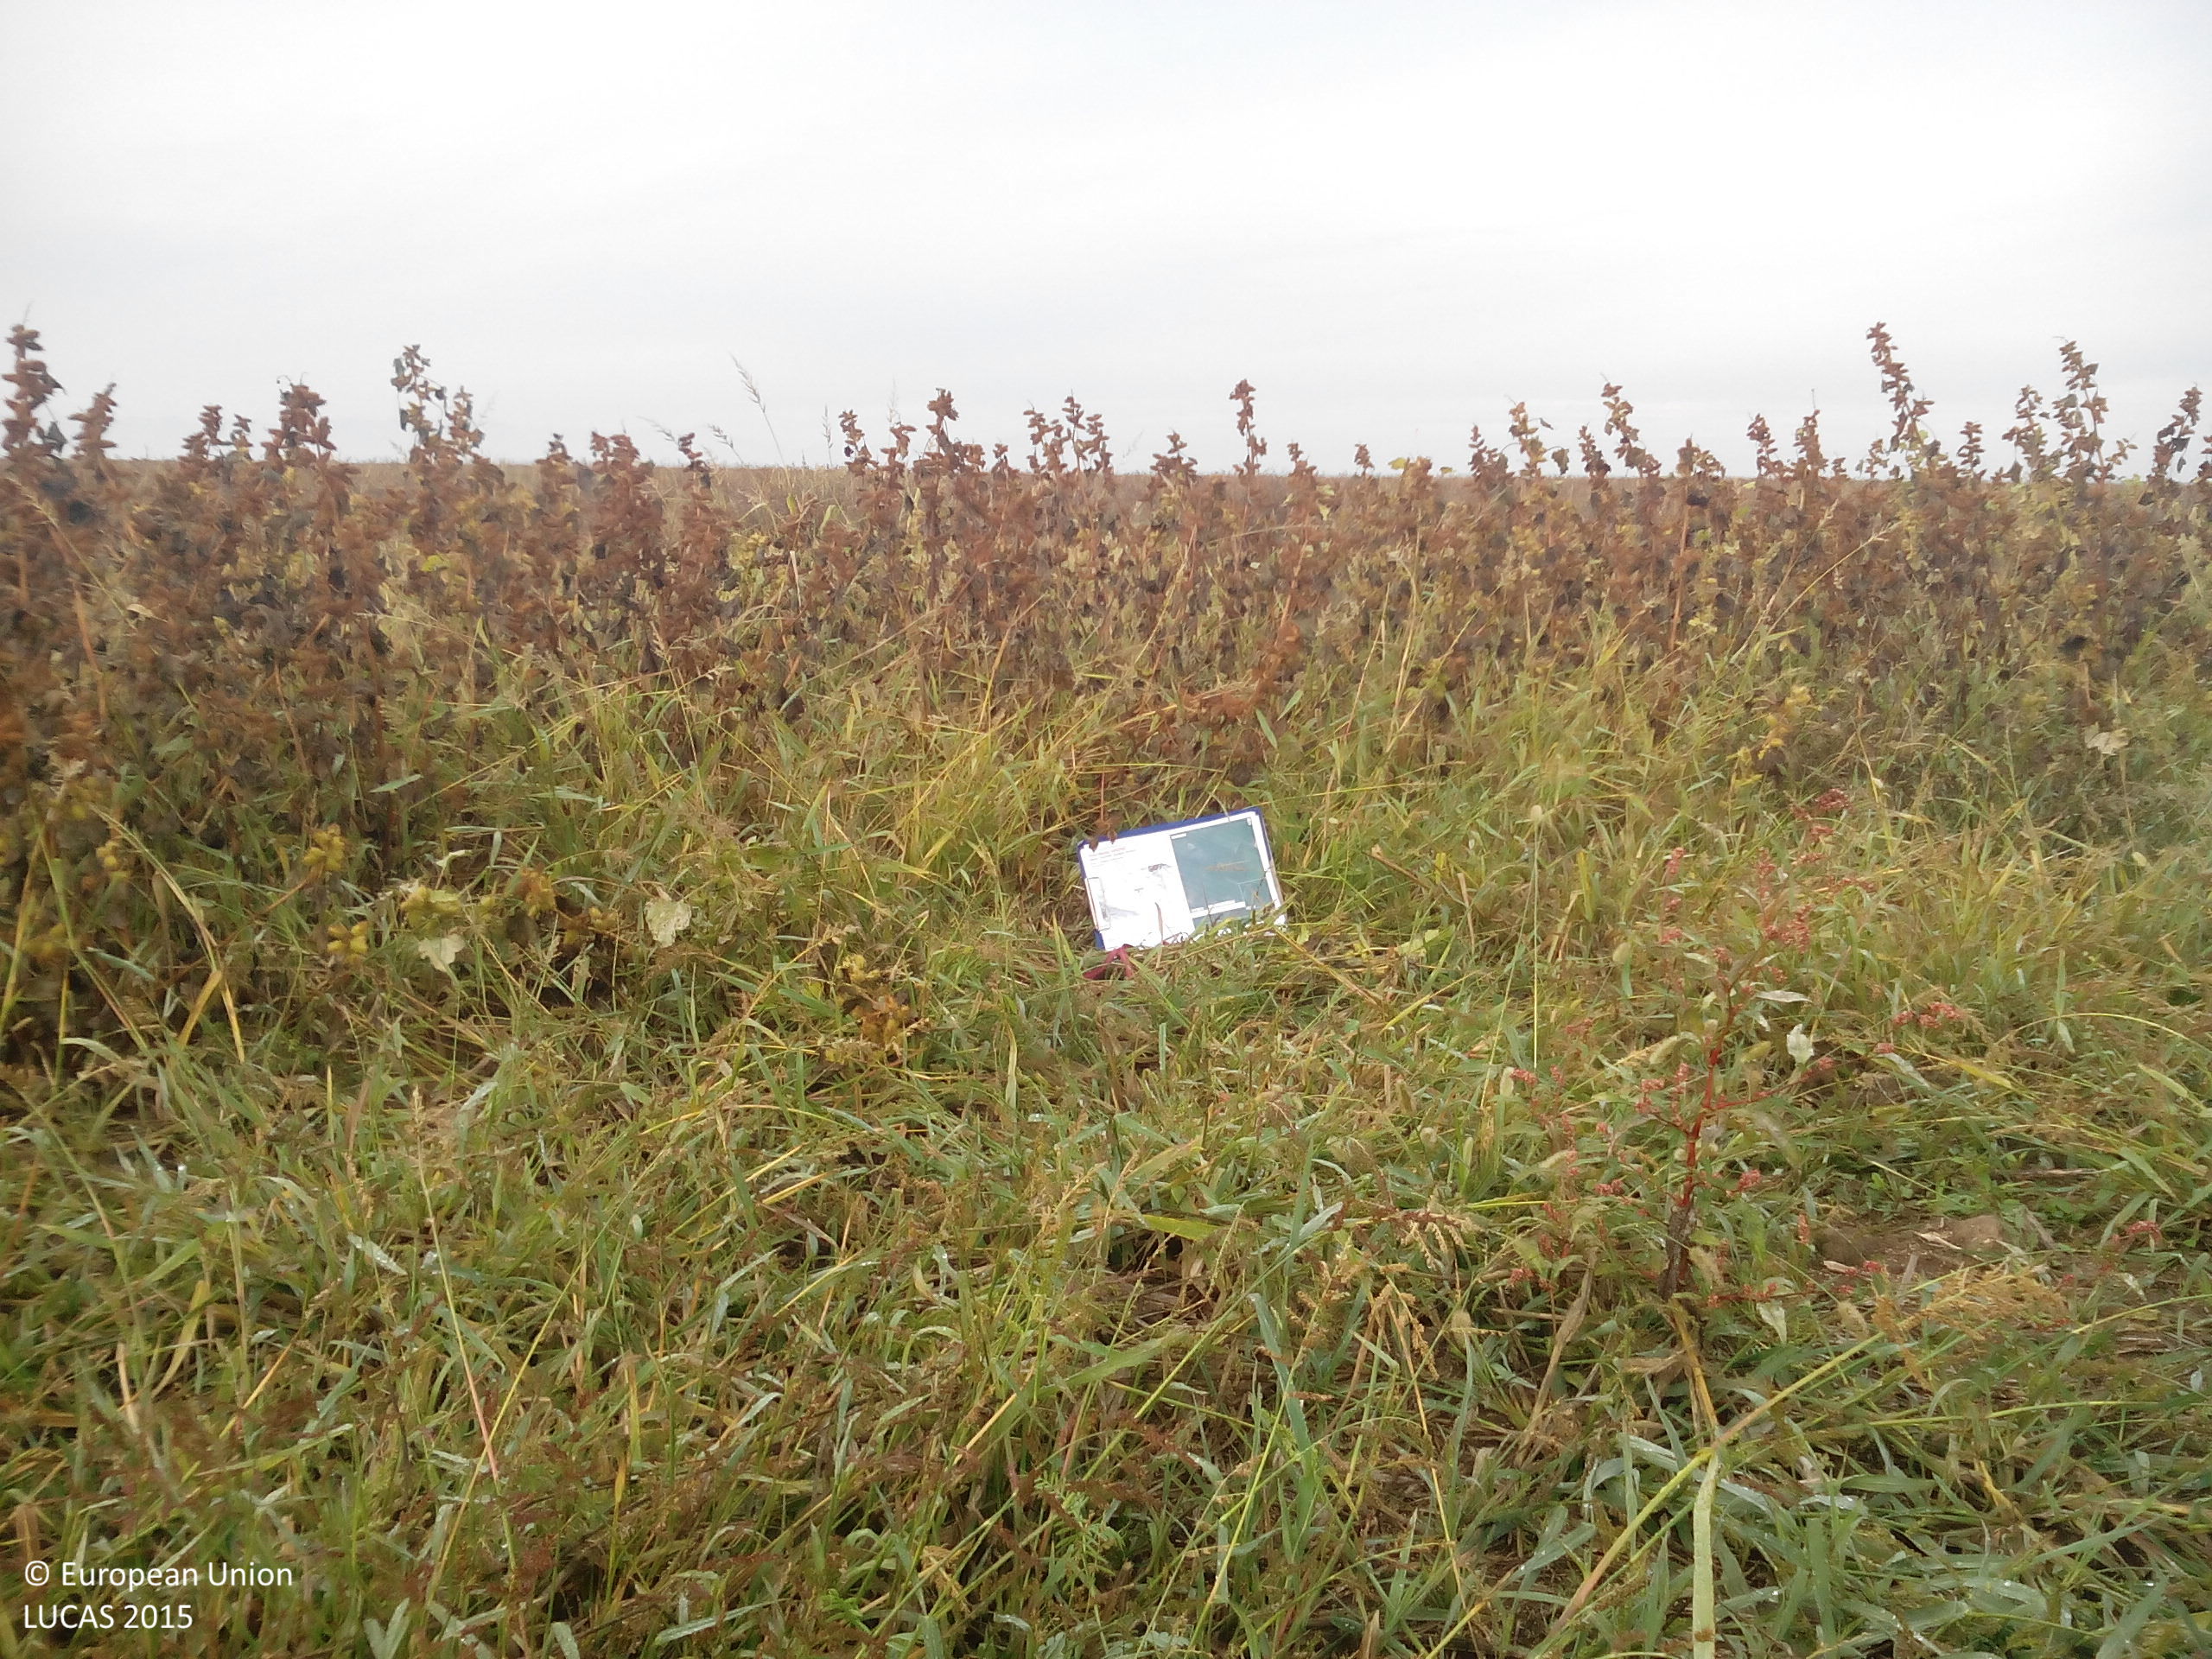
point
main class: Grassland
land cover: Spontaneously vegetated surfaces
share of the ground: > 75 %
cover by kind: herbaceous plants 90 %, unconsolidated bare surface 10 %
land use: Fallow land
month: October
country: BG
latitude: 43.4614
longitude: 23.6546
